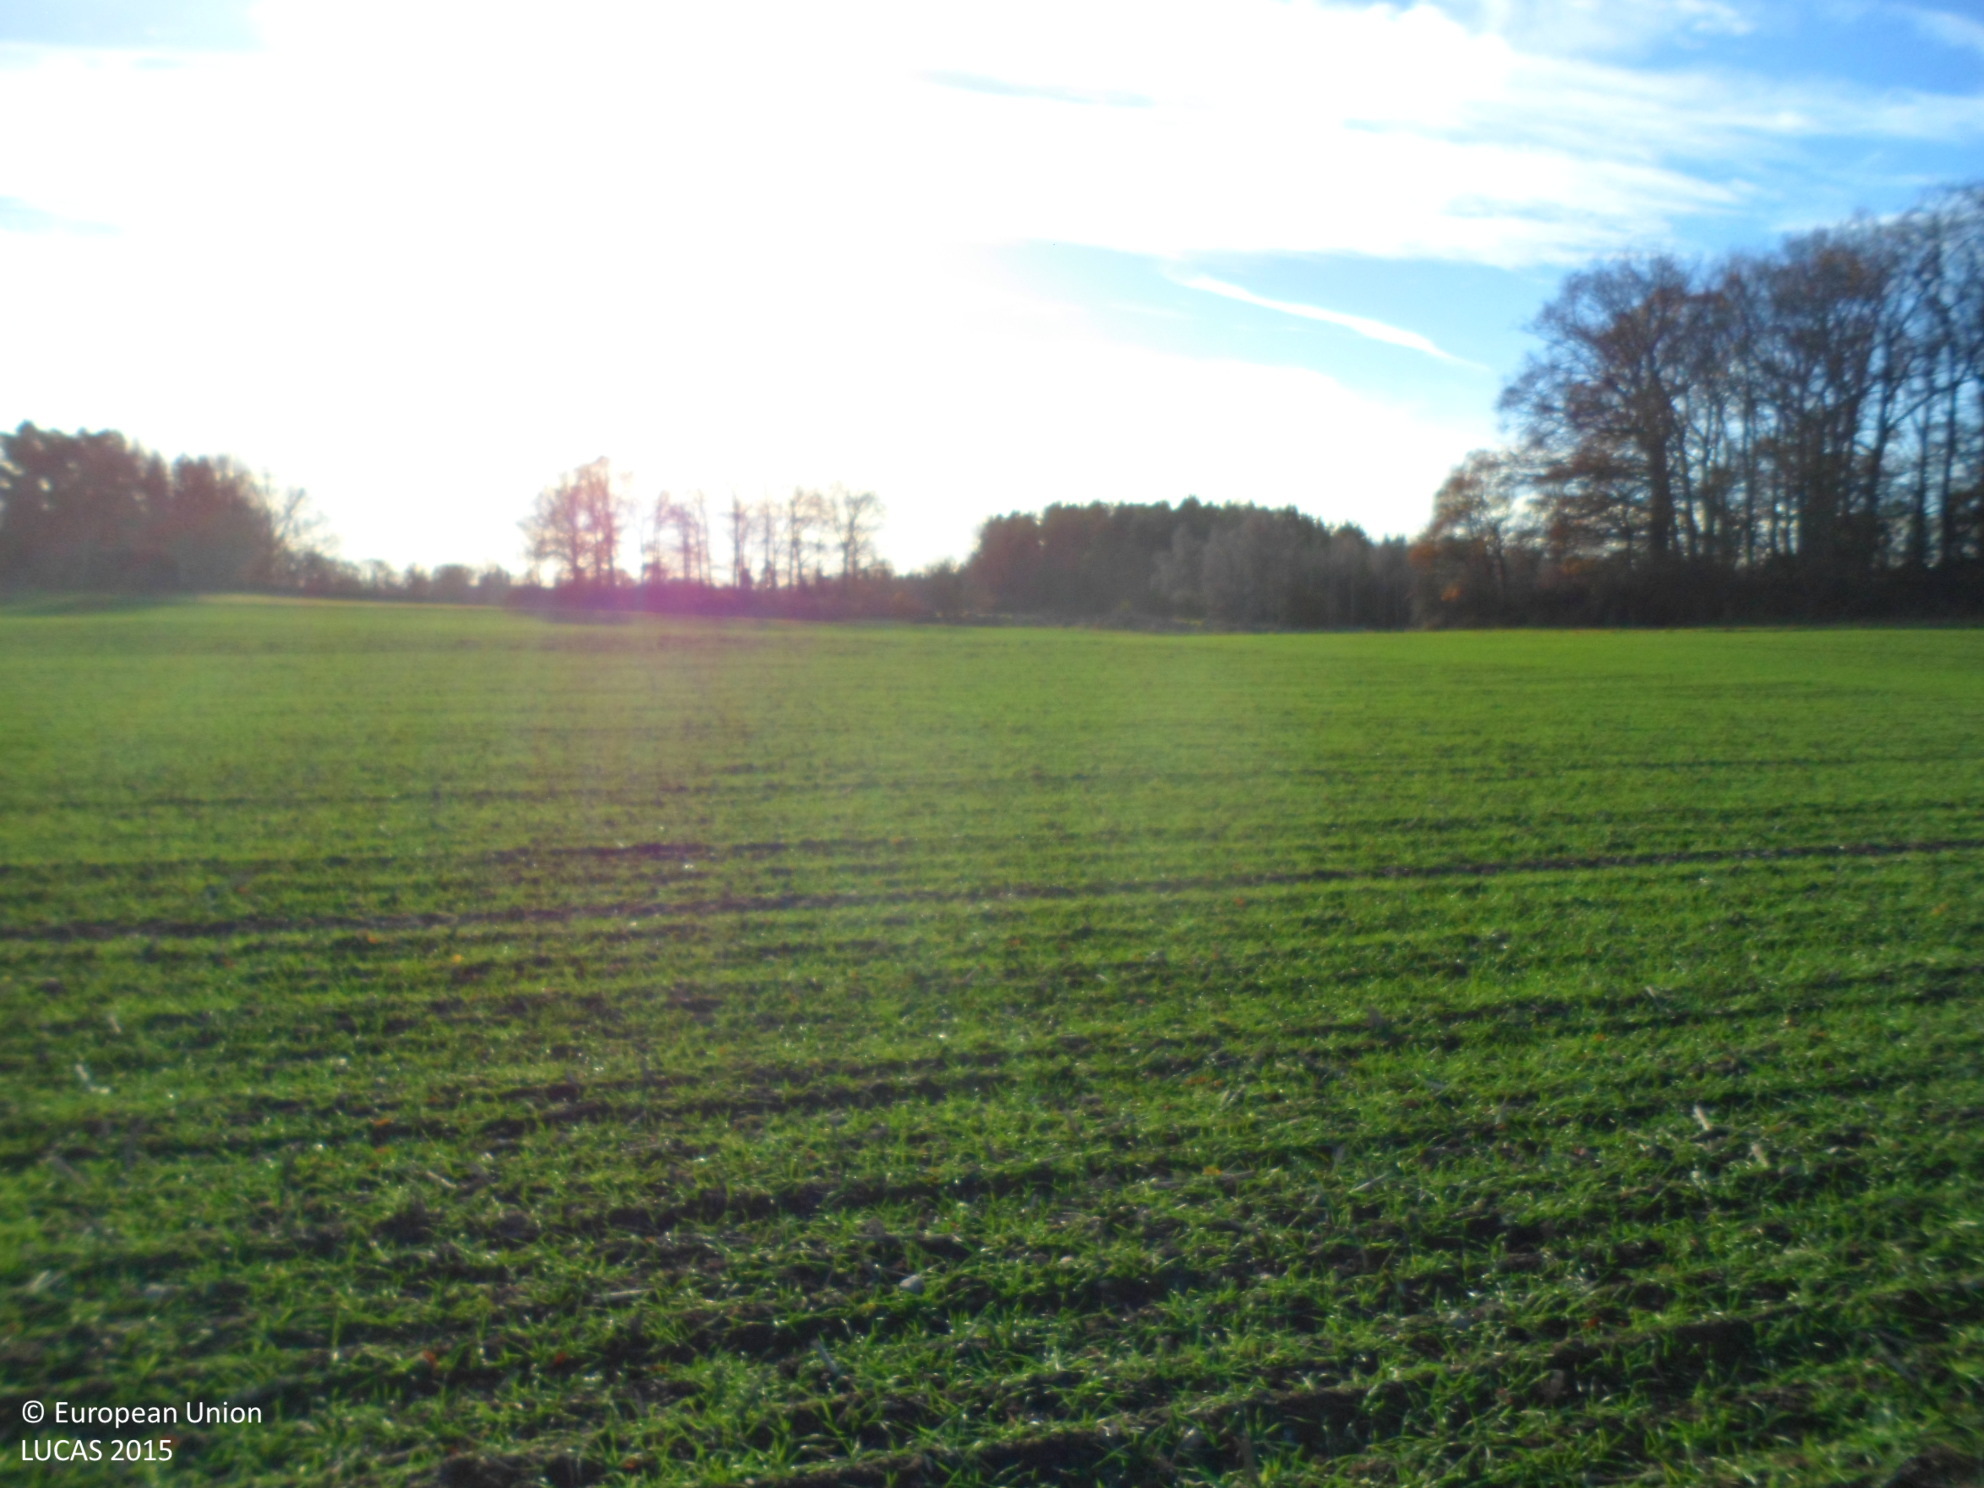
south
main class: Cropland
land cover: Common wheat
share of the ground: 50 - 75 %
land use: Agriculture (excluding fallow land and kitchen gardens)
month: November
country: SE
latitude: 56.5820
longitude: 16.1382
